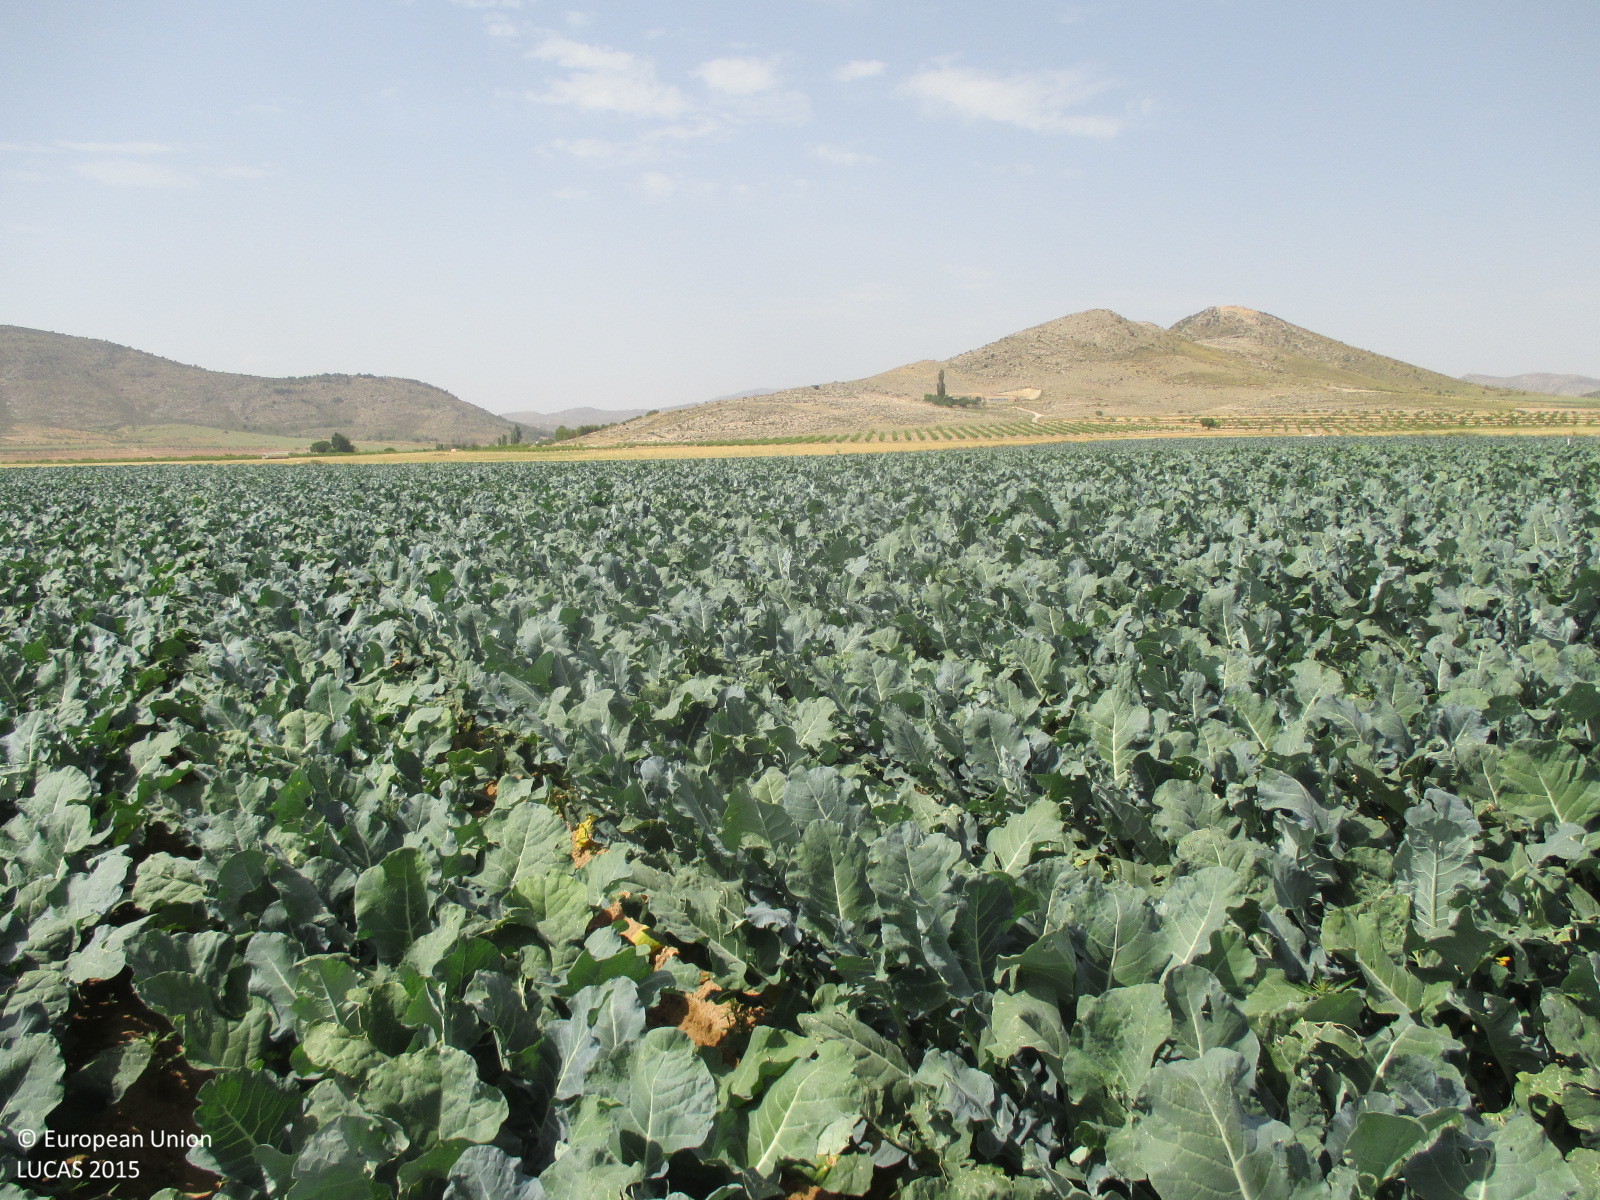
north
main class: Cropland
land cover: Other fresh vegetables
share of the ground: > 75 %
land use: Agriculture (excluding fallow land and kitchen gardens)
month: July
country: ES
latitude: 37.9039
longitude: -2.3982
